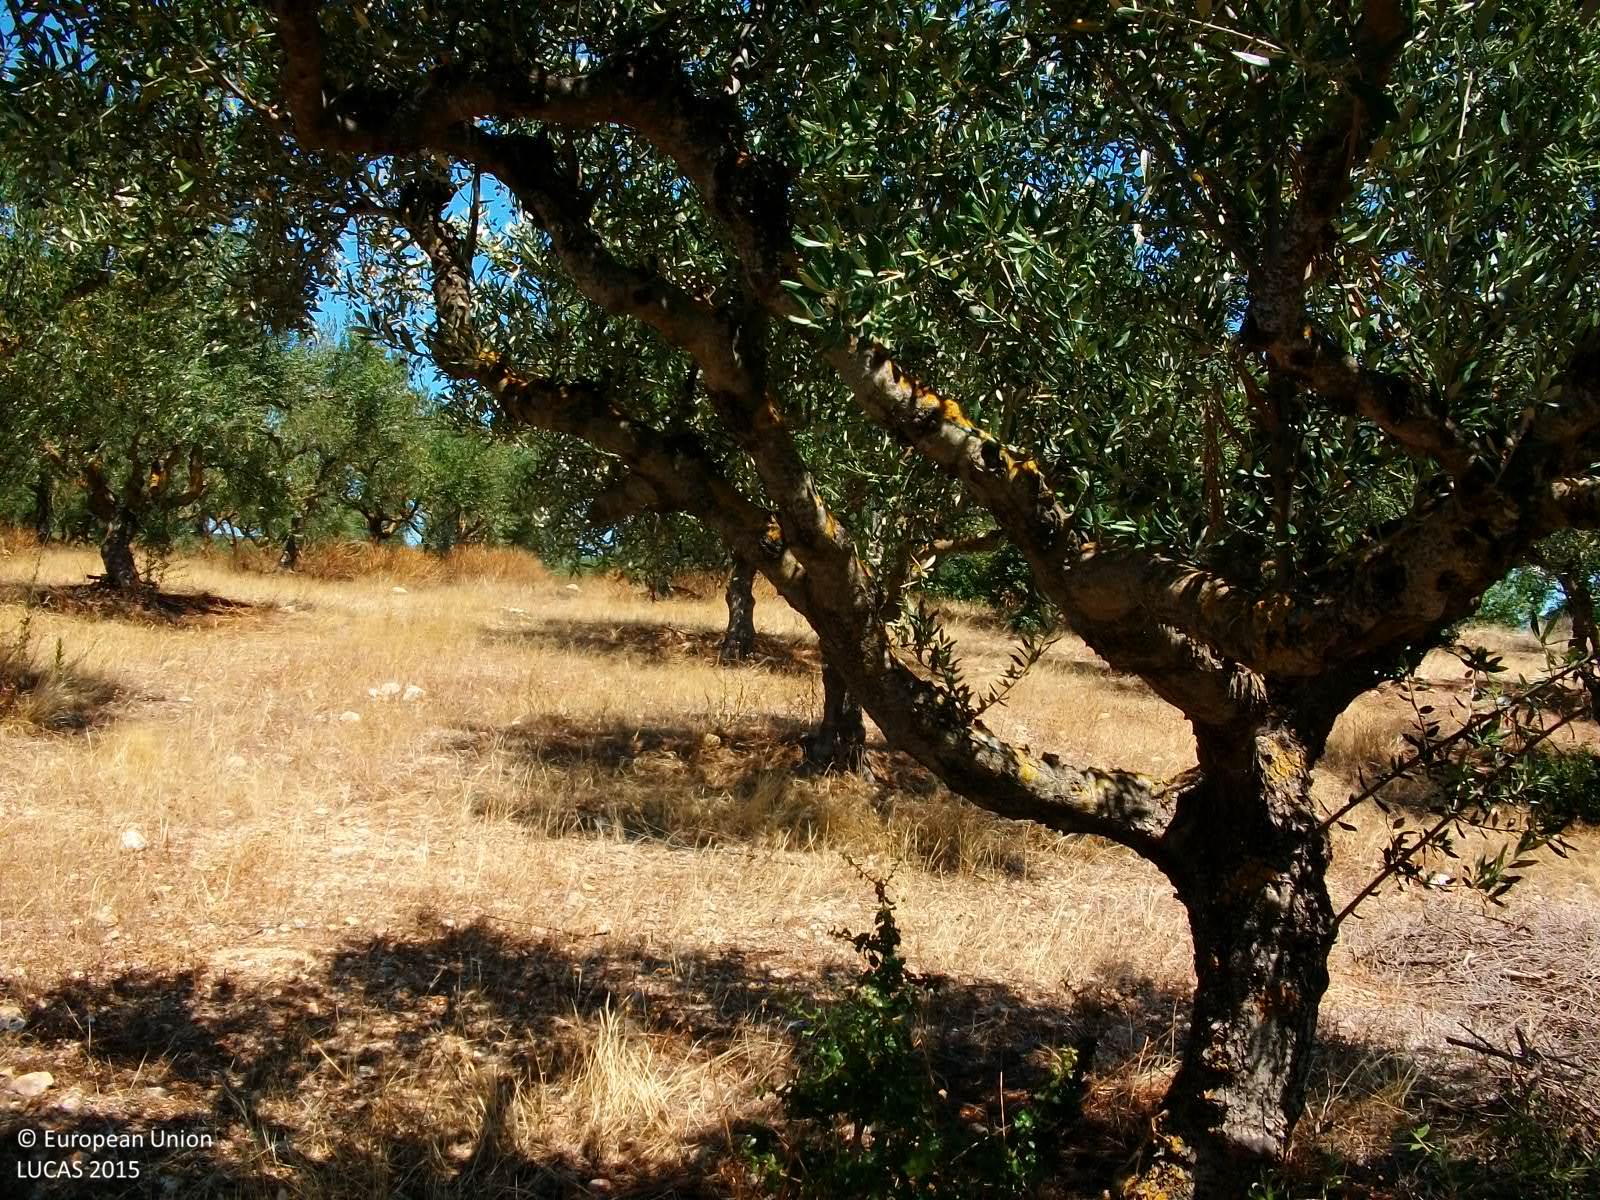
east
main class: Cropland
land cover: Olive groves
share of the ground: 25 - 50 %
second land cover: Spontaneously vegetated surfaces
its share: > 75 %
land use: Agriculture (excluding fallow land and kitchen gardens)
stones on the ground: > 50 %
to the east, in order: Olive groves; Spontaneously vegetated surfaces; Grass margins; Tracks; Grass margins; Olive groves; Shrubland without tree cover; Olive groves; Shrubland without tree cover
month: July
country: GR
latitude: 36.8752
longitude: 21.8530
